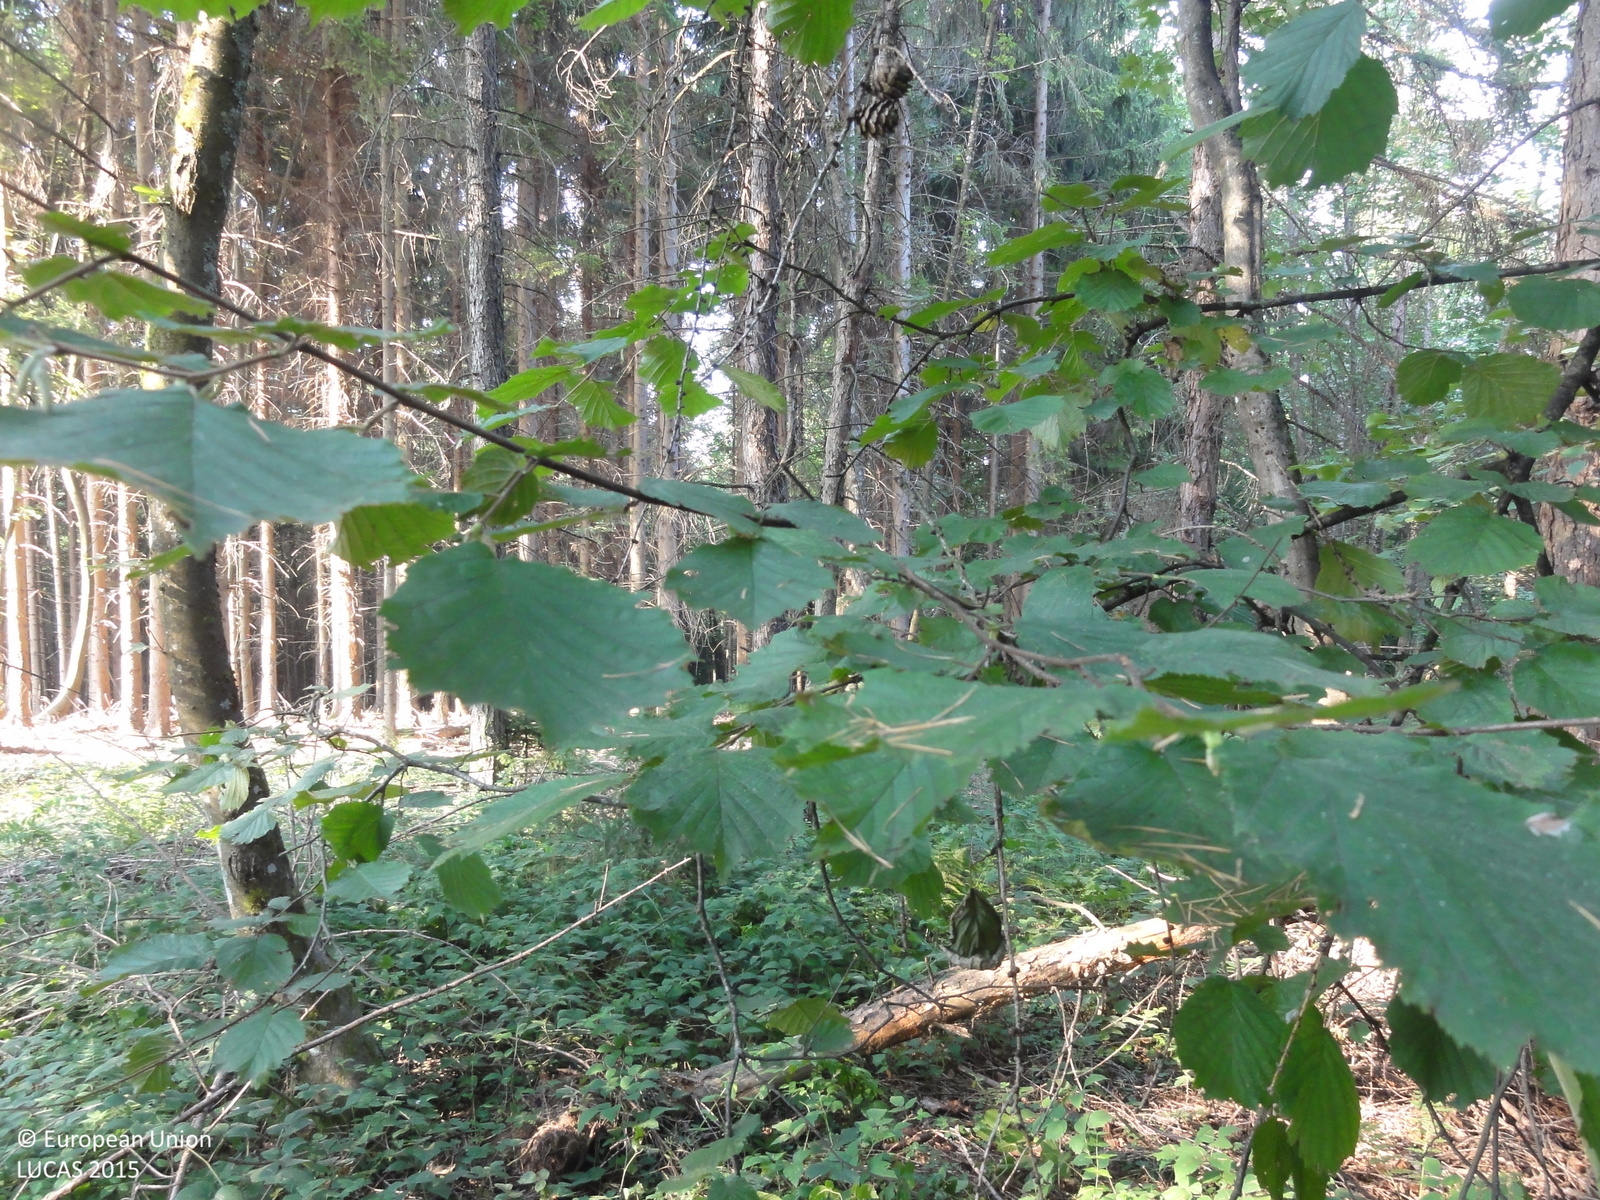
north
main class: Woodland
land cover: Spruce dominated mixed woodland
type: mesophytic deciduous forest
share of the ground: > 75 %
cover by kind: broadleaved forest trees 60 %, coniferous forest trees 40 %
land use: Forestry
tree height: > 5 m
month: August
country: SI
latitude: 45.8179
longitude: 15.0287
